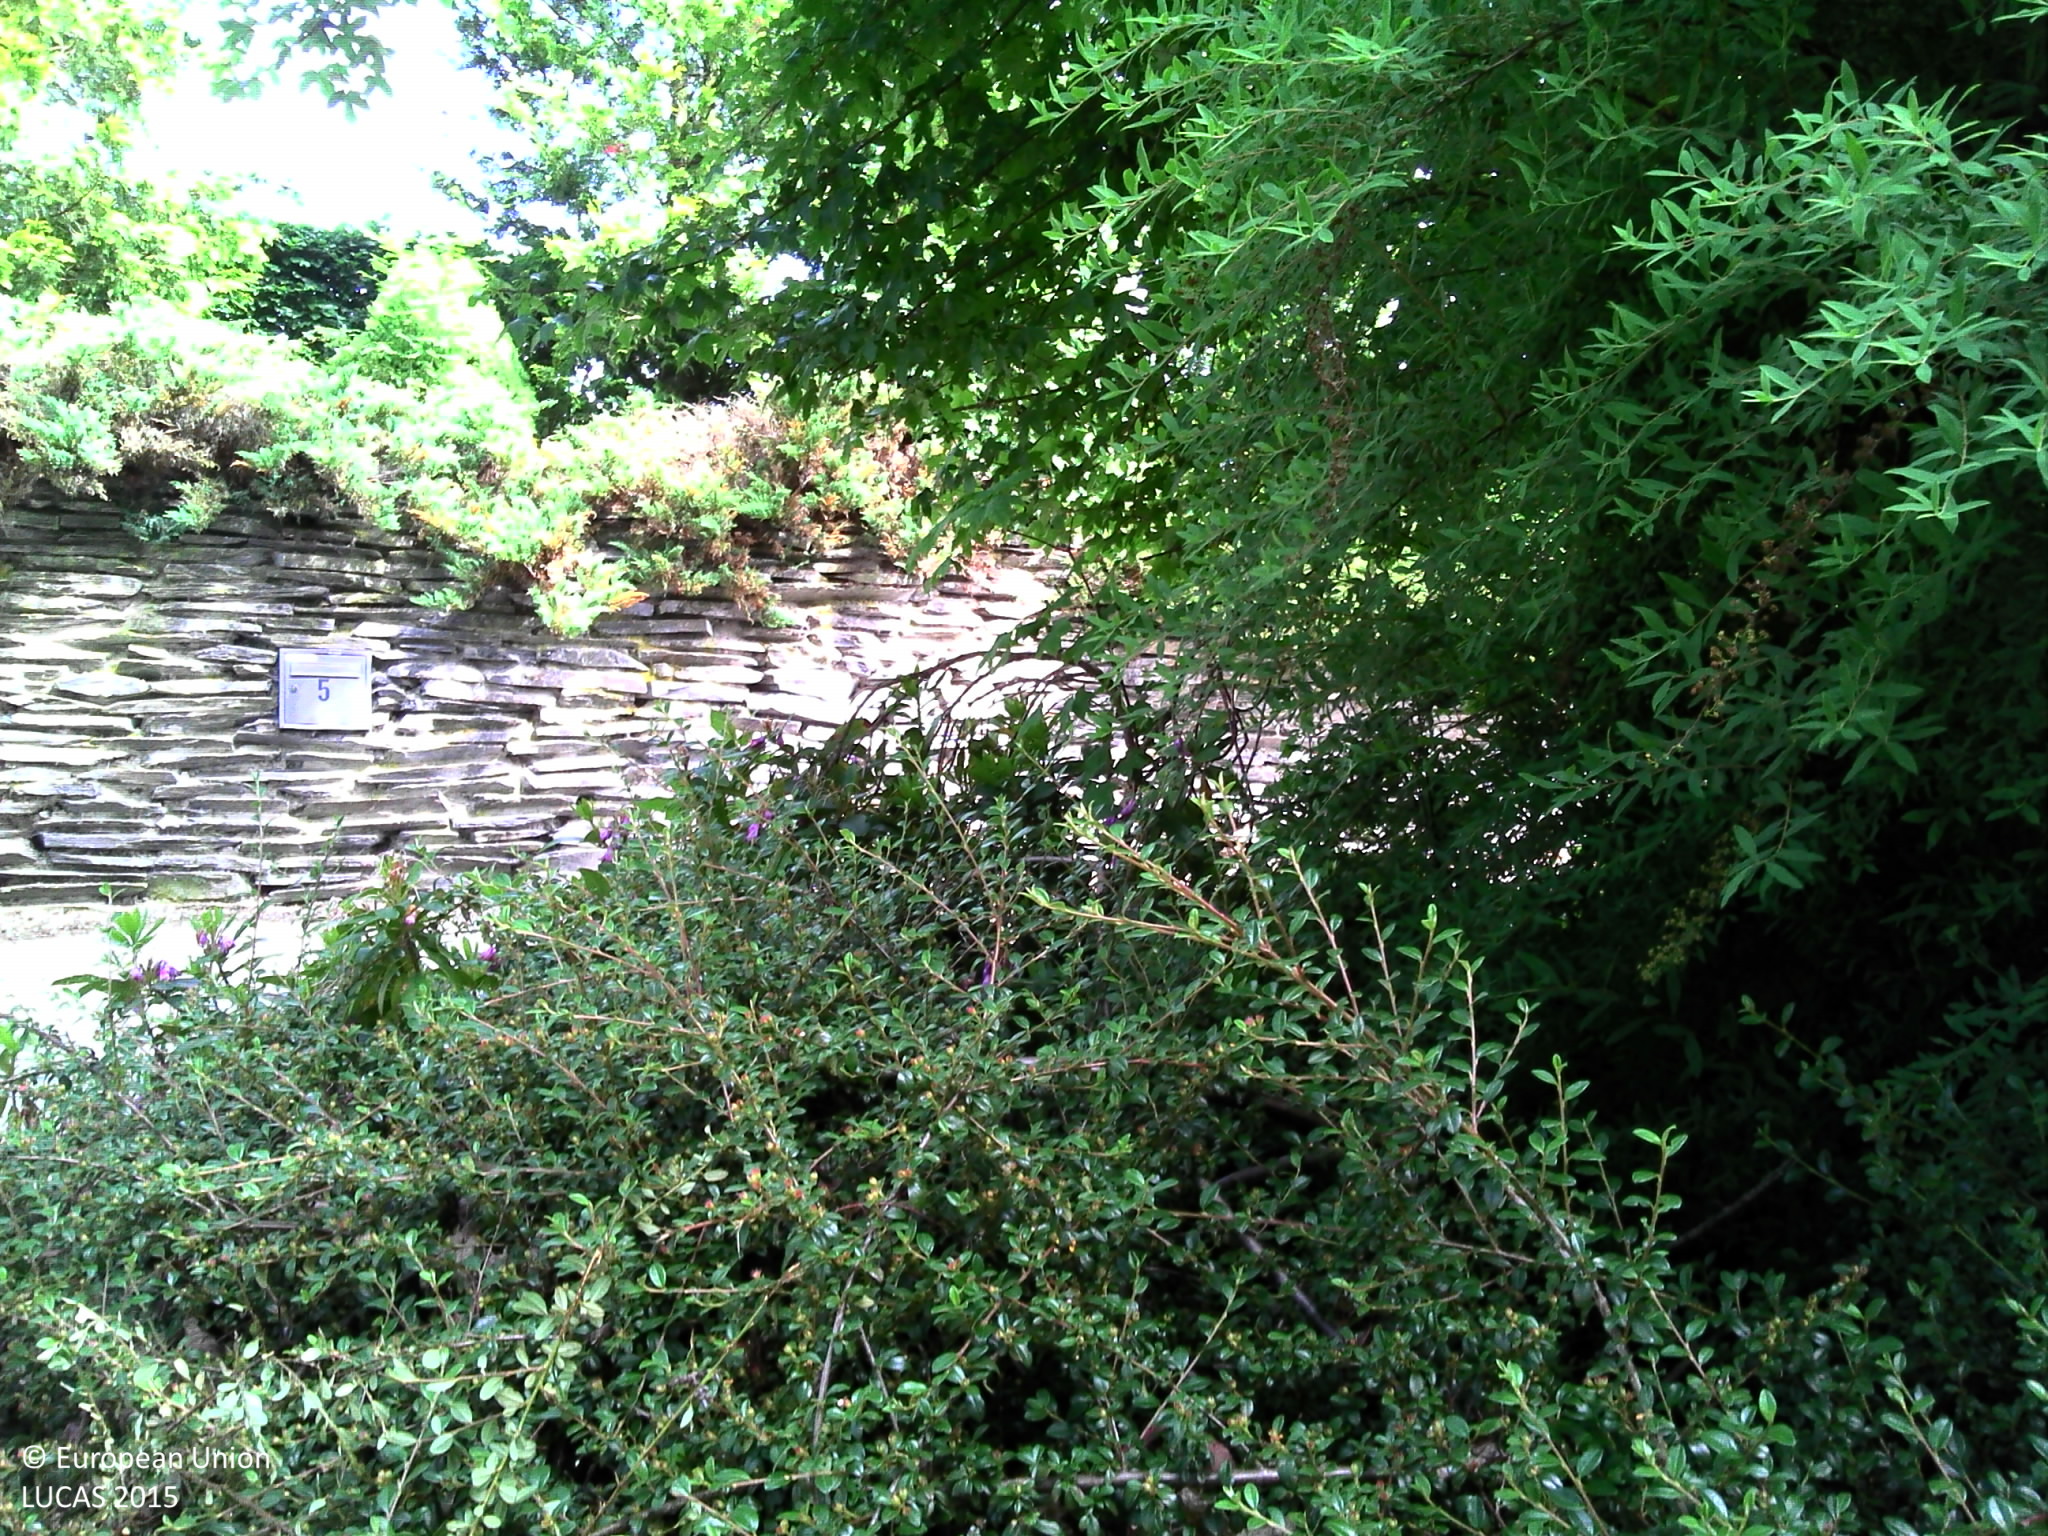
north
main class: Woodland
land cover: Broadleaved woodland
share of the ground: > 75 %
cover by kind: broadleaved forest trees 95 %, shrubs 5 %
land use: Residential
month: June
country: BE
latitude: 50.0354
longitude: 5.3489
